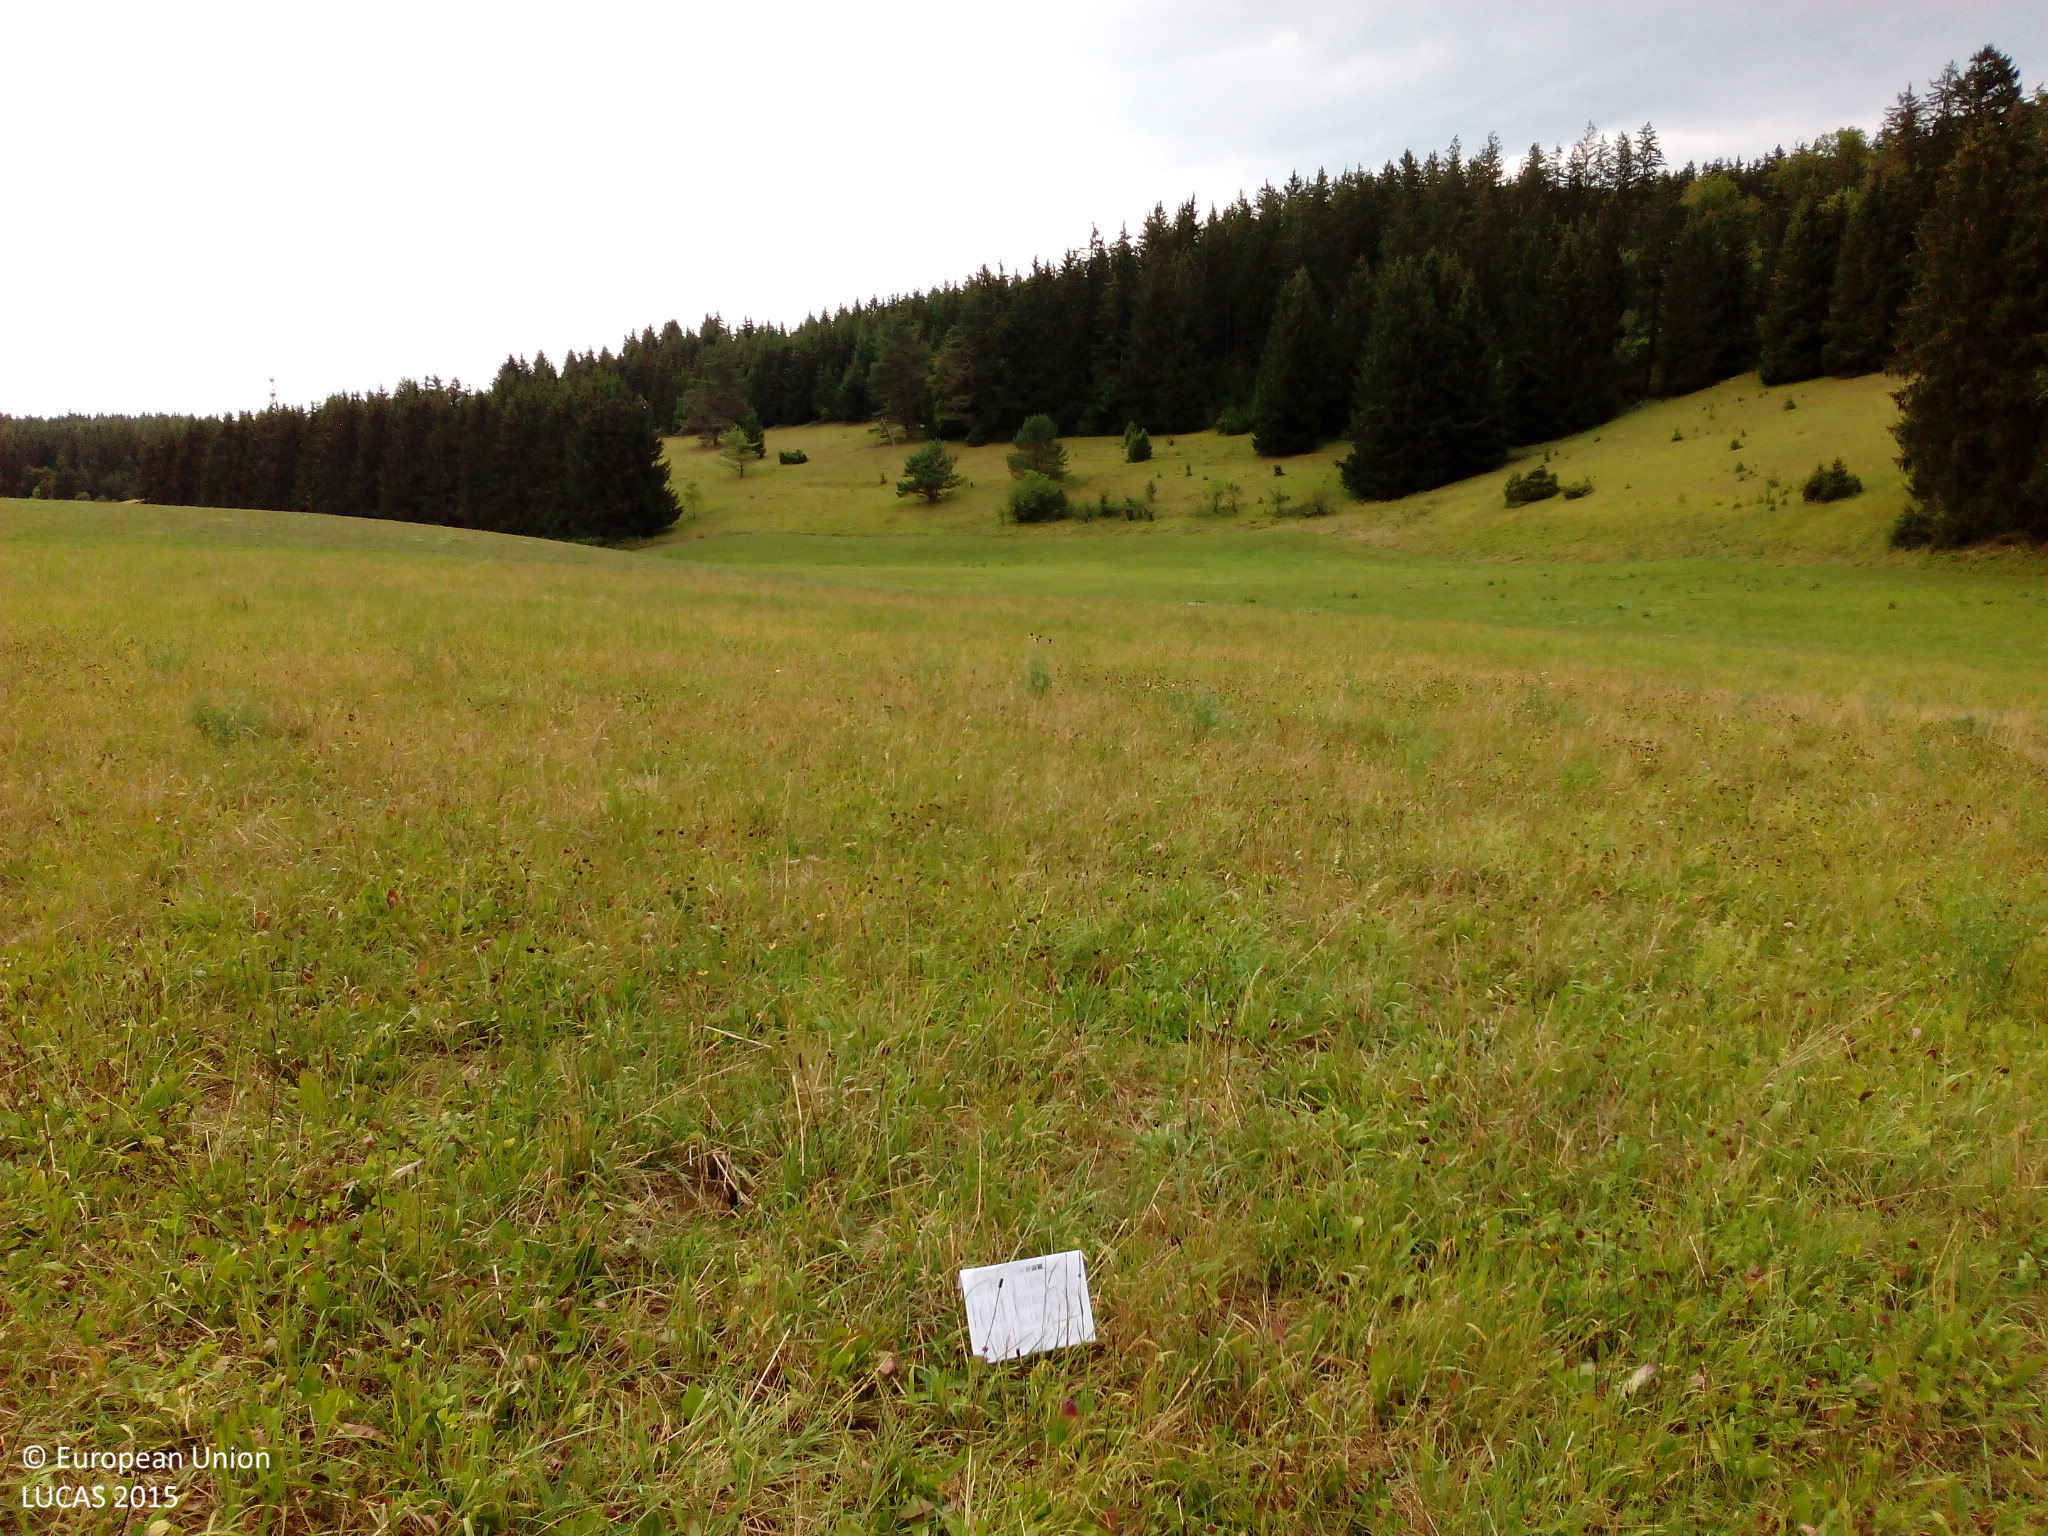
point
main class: Grassland
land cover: Grassland without tree/shrub cover
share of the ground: > 75 %
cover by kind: herbaceous plants 95 %, unconsolidated bare surface 5 %
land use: Agriculture (excluding fallow land and kitchen gardens)
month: August
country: DE
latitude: 48.6194
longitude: 9.9593
